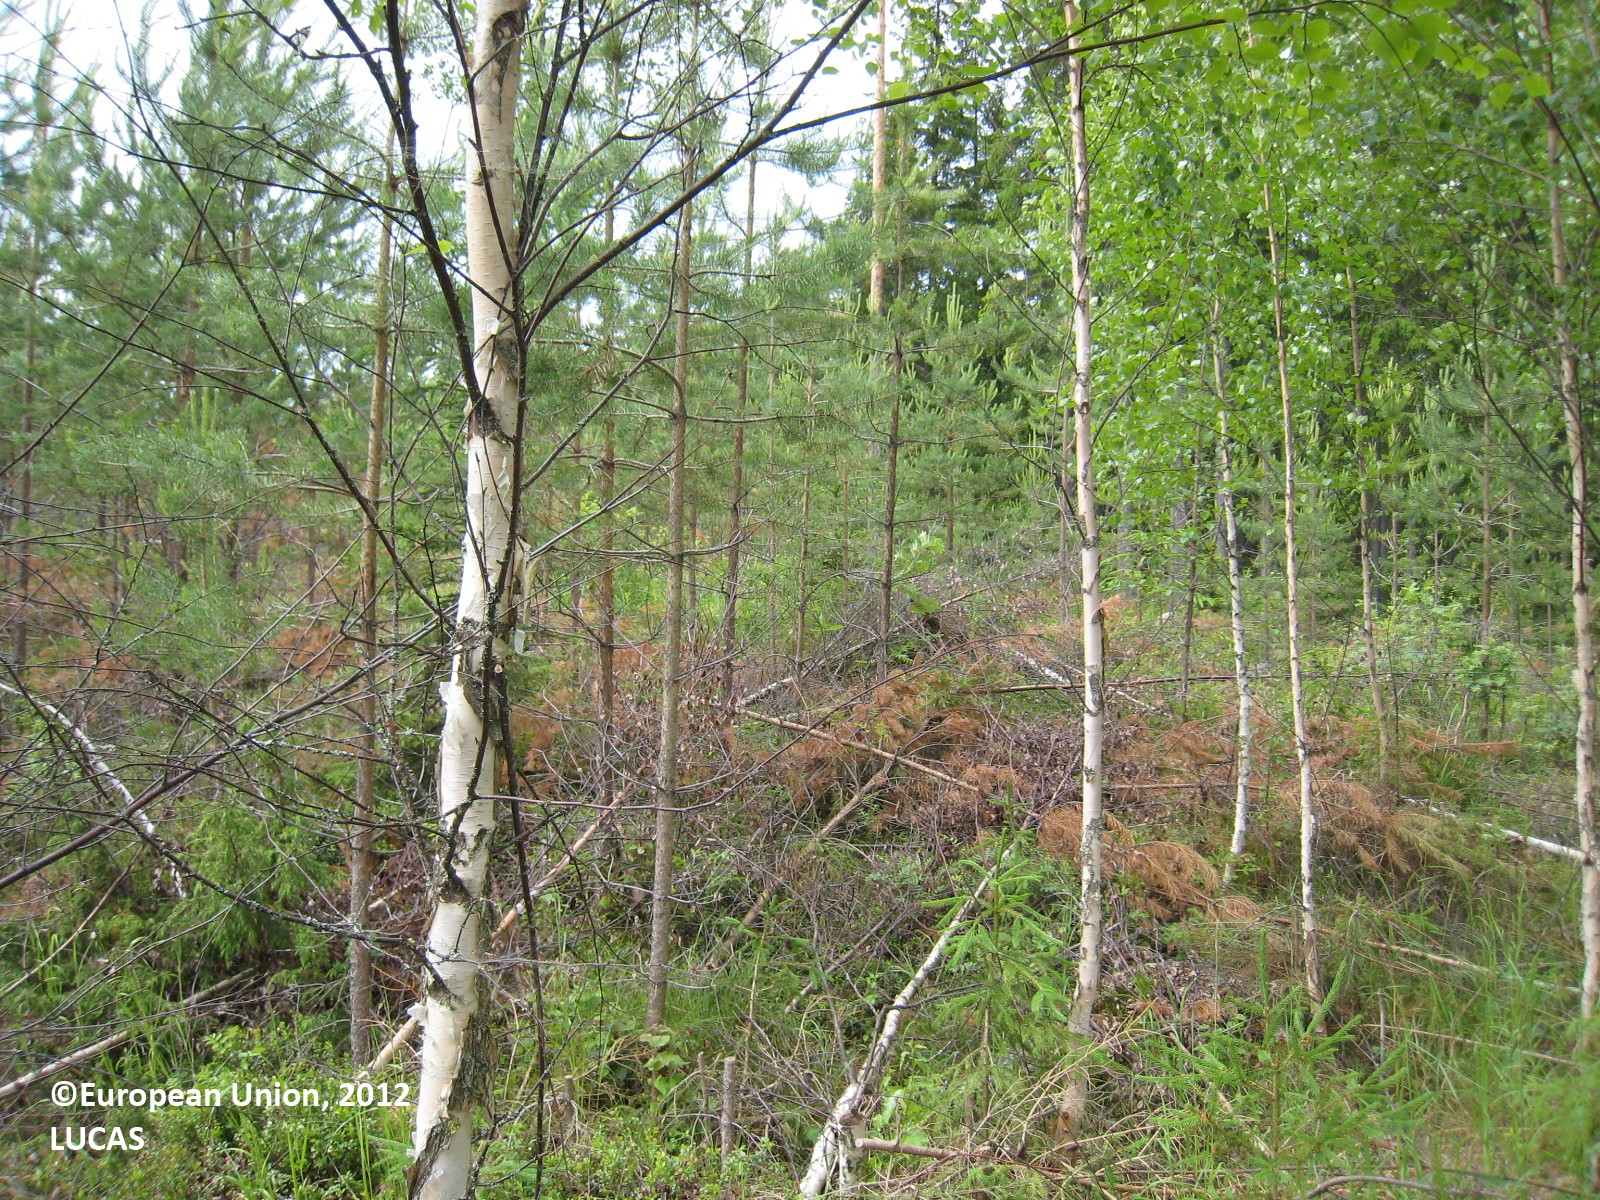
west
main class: Woodland
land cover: Broadleaved woodland
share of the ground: 50 - 75 %
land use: Forestry
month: June
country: FI
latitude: 62.2223
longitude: 26.3901
